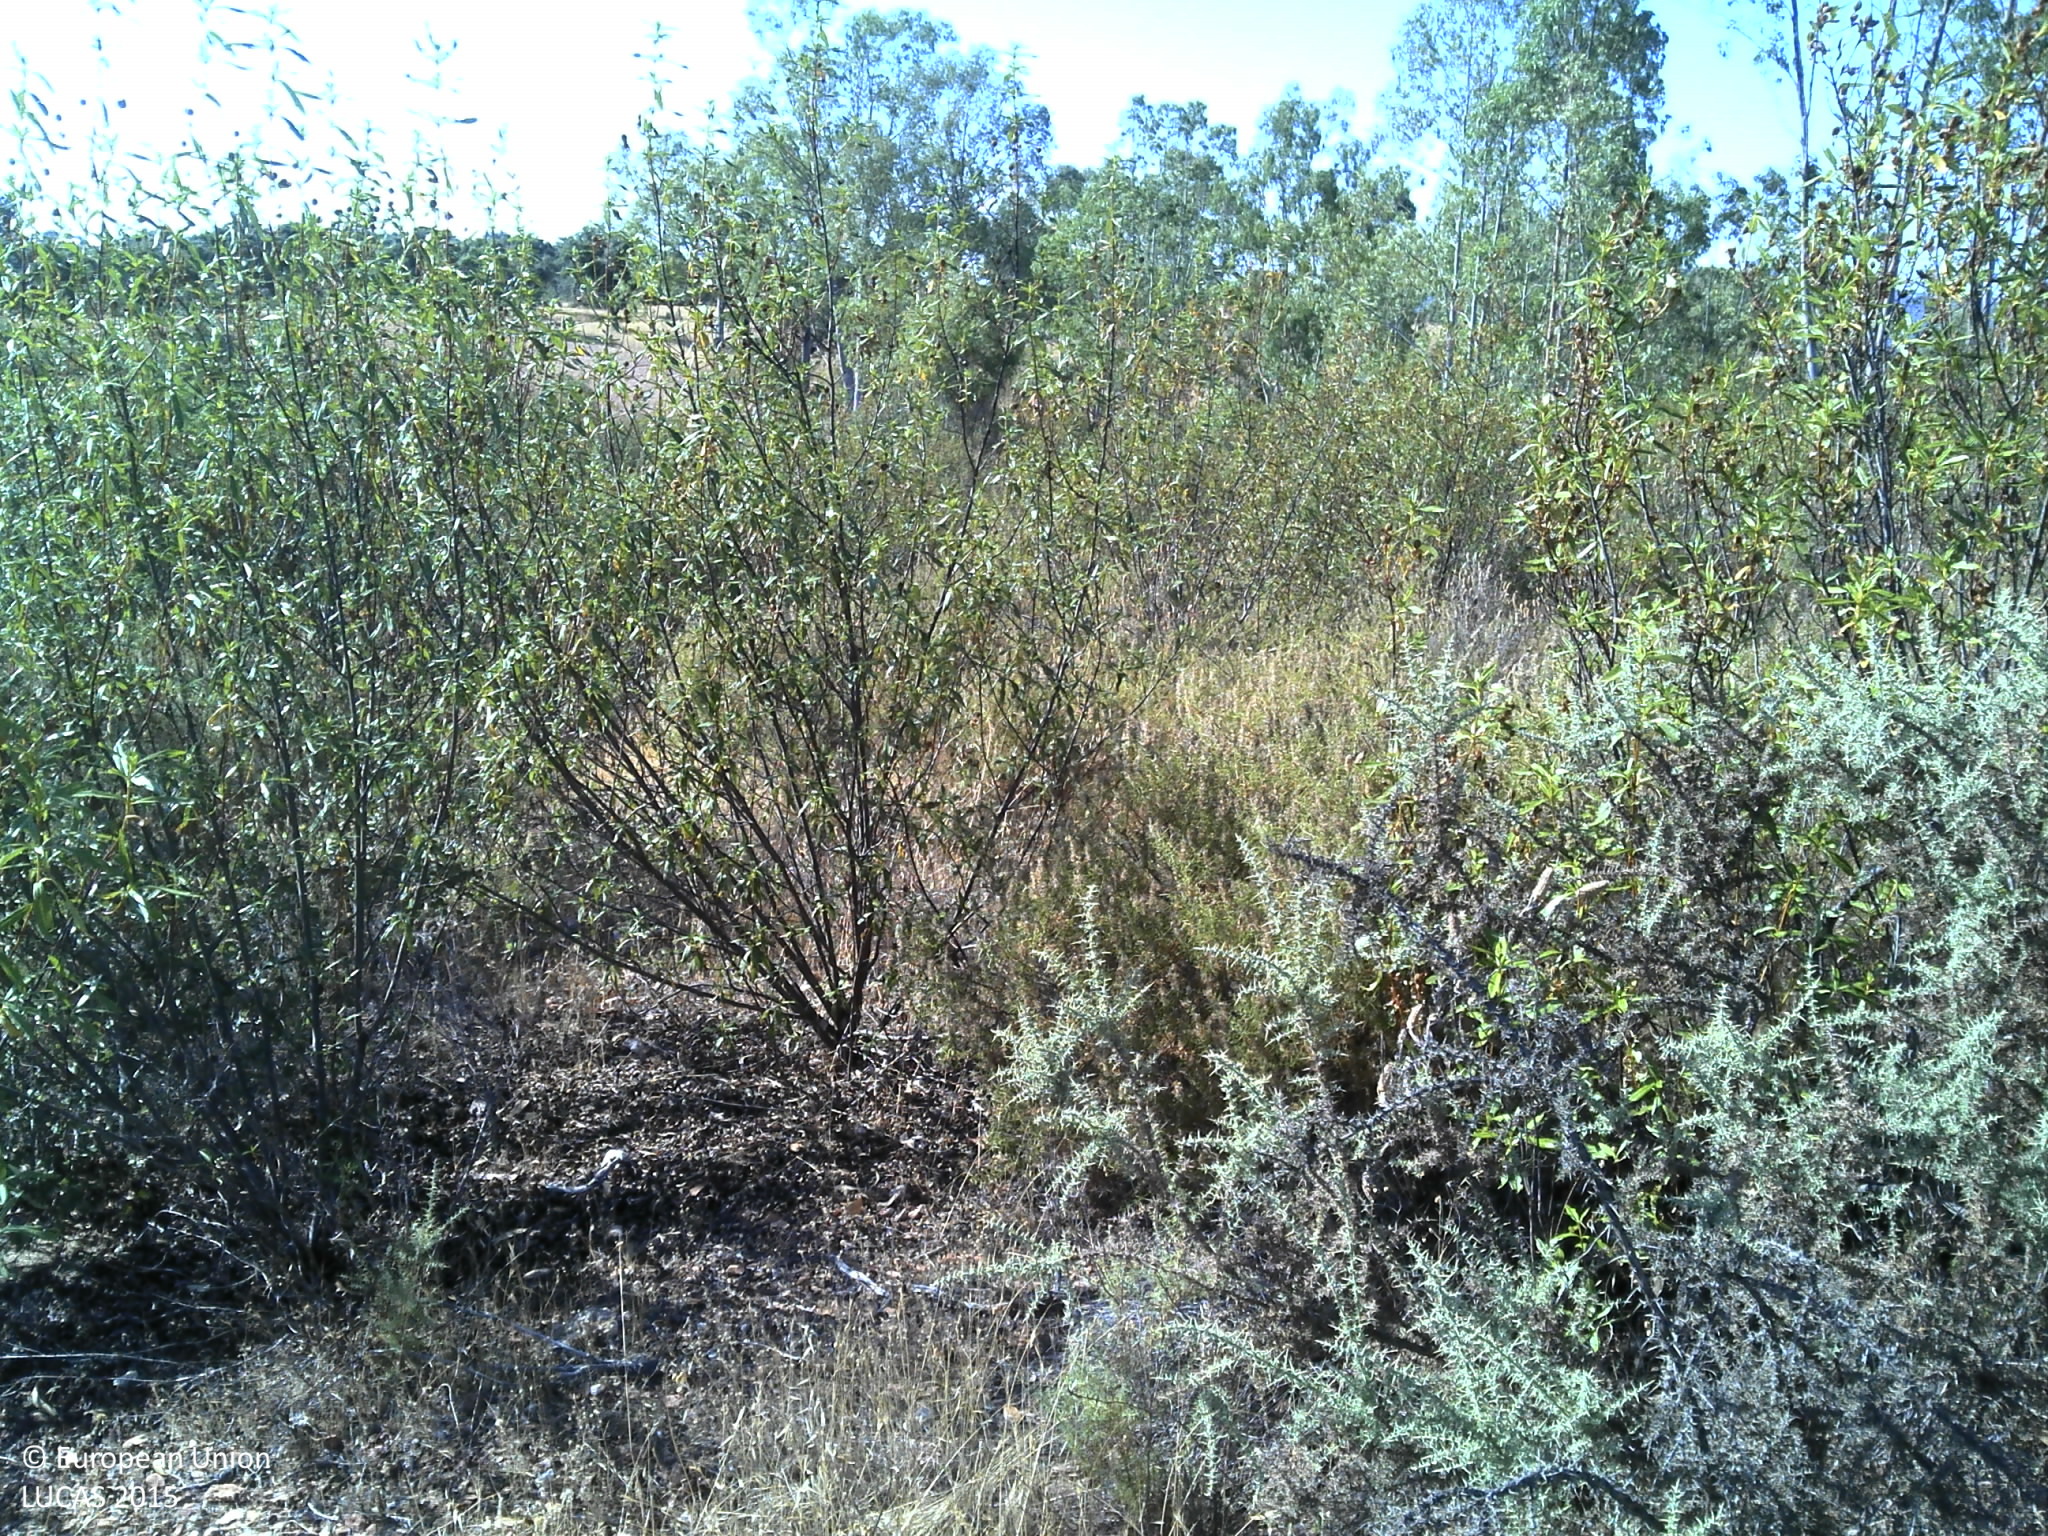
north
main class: Shrubland
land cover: Shrubland with sparse tree cover
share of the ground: > 75 %
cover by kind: shrubs 90 %, broadleaved forest trees 5 %, unconsolidated bare surface 5 %
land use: Abandoned areas
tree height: < 5 m
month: June
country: PT
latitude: 37.9068
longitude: -7.2892
